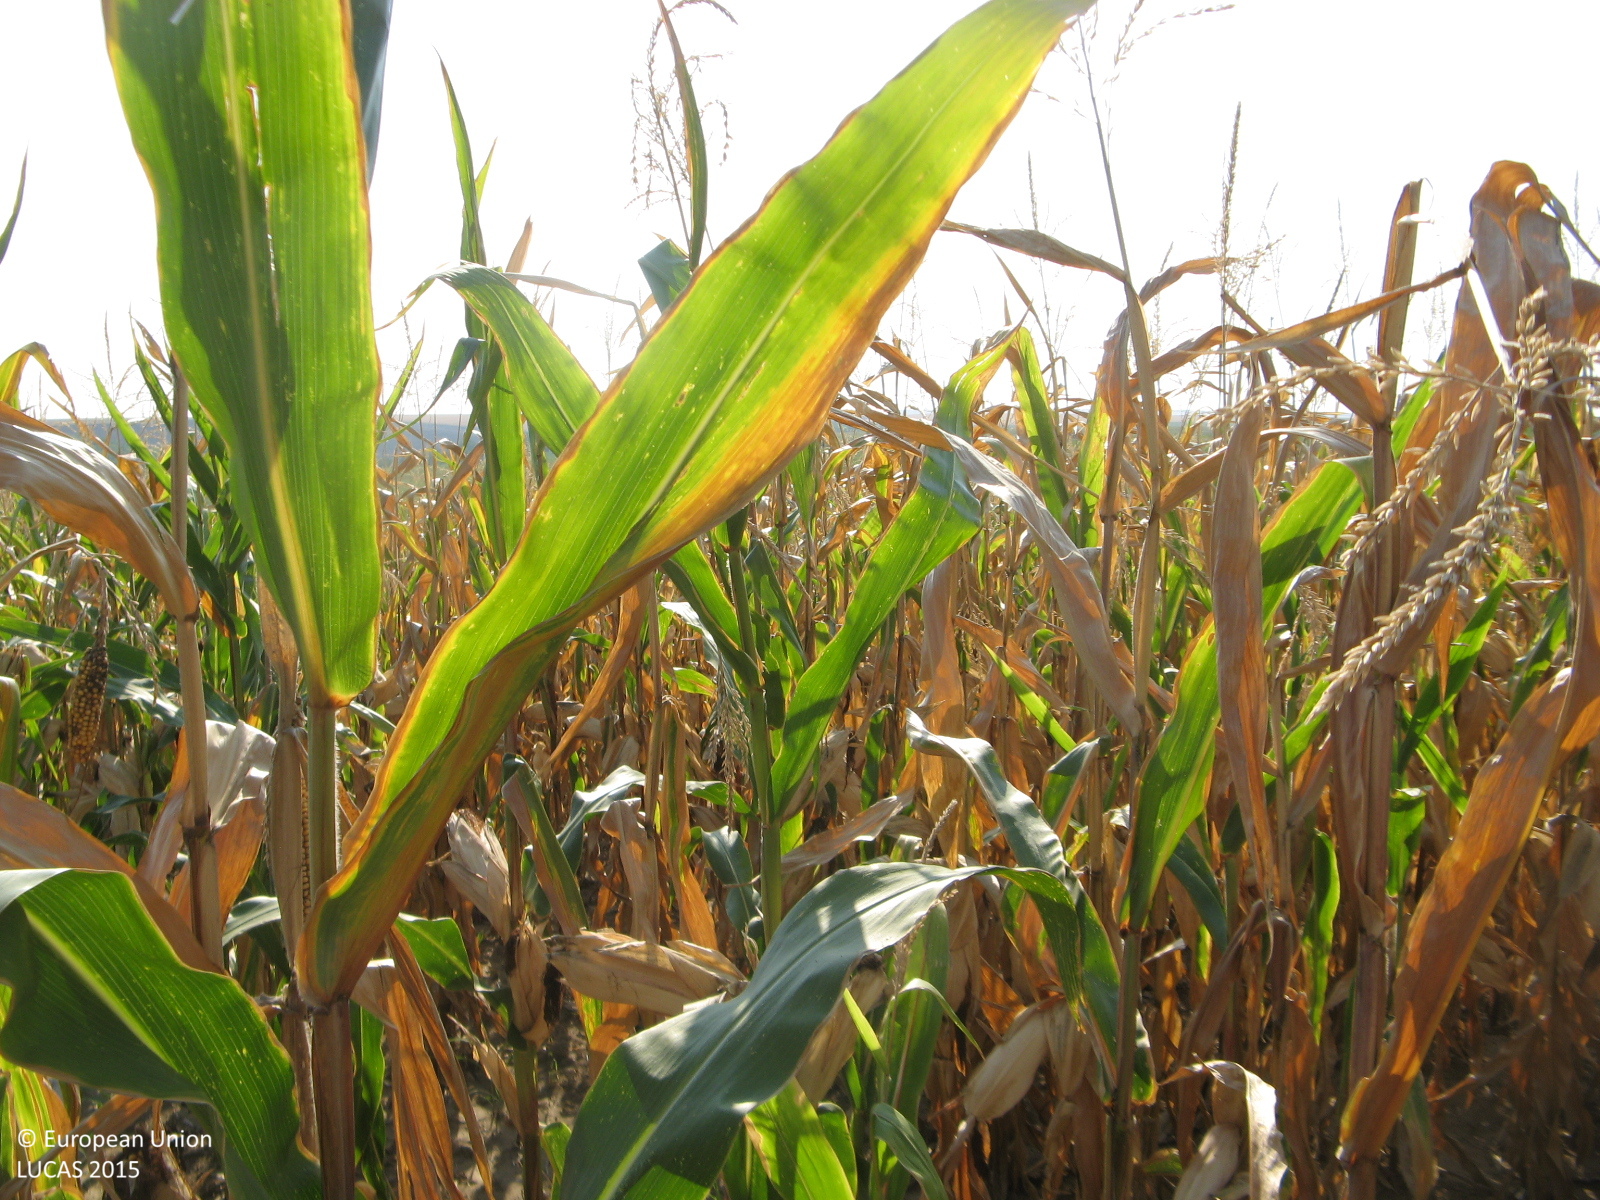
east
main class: Cropland
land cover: Maize
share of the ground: > 75 %
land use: Agriculture (excluding fallow land and kitchen gardens)
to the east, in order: Maize
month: September
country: BG
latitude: 43.5899
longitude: 25.6803
